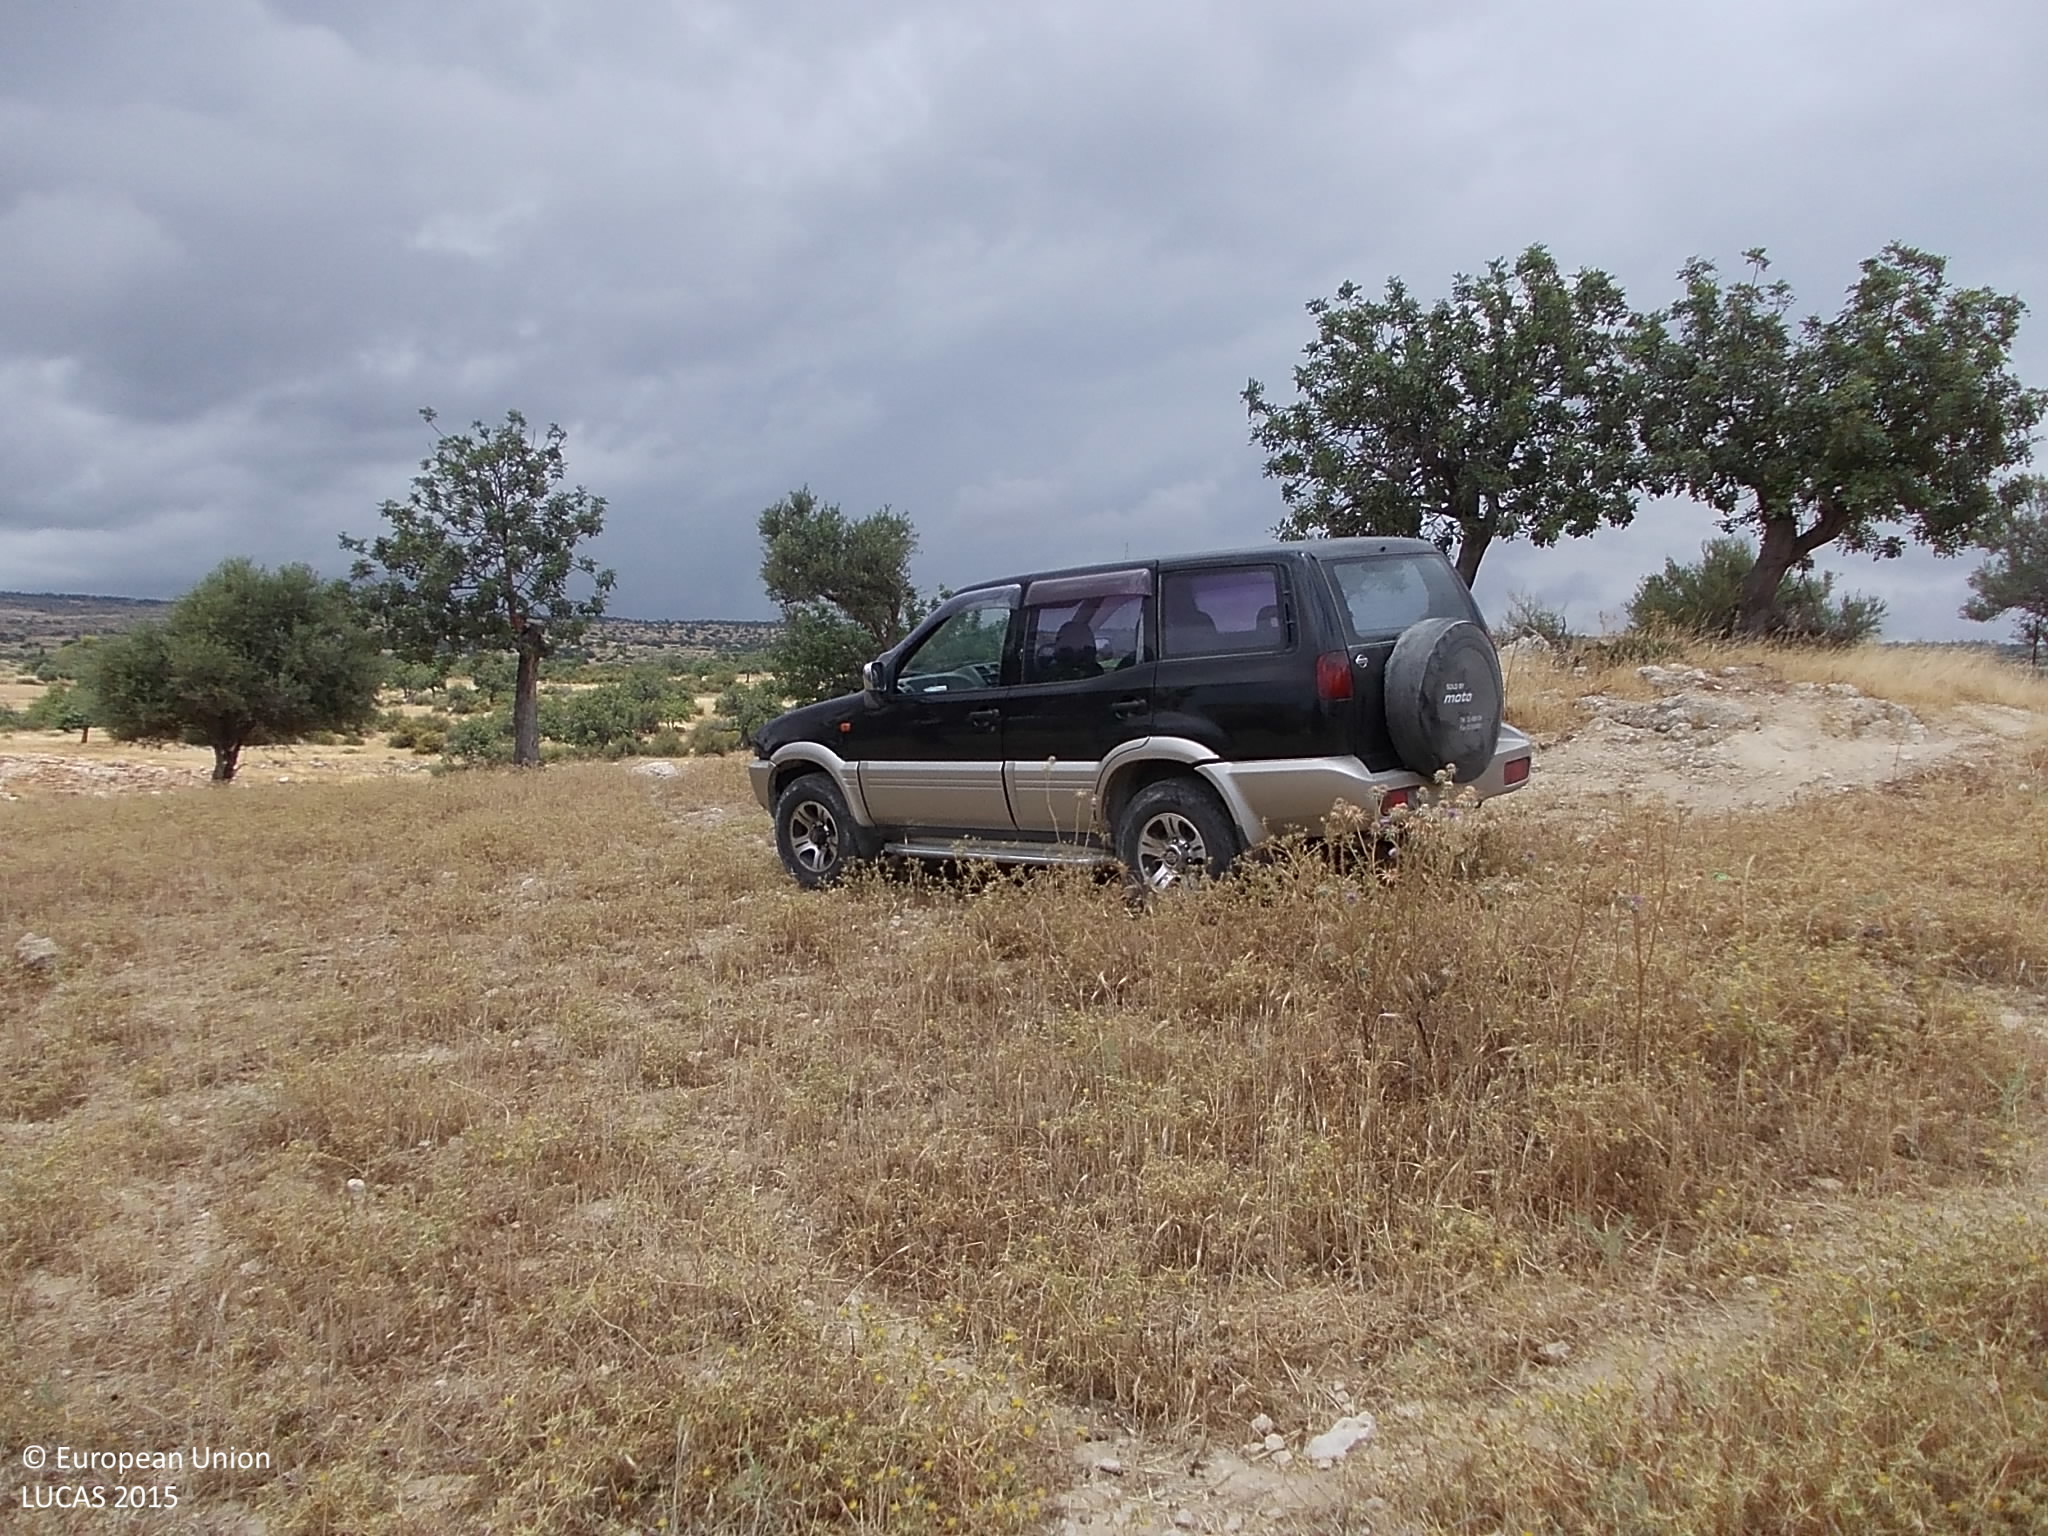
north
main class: Cropland
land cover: Permanent industrial crops
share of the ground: 10 - 25 %
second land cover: Spontaneously vegetated surfaces
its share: > 75 %
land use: Agriculture (excluding fallow land and kitchen gardens)
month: May
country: CY
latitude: 34.7037
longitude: 32.7652
